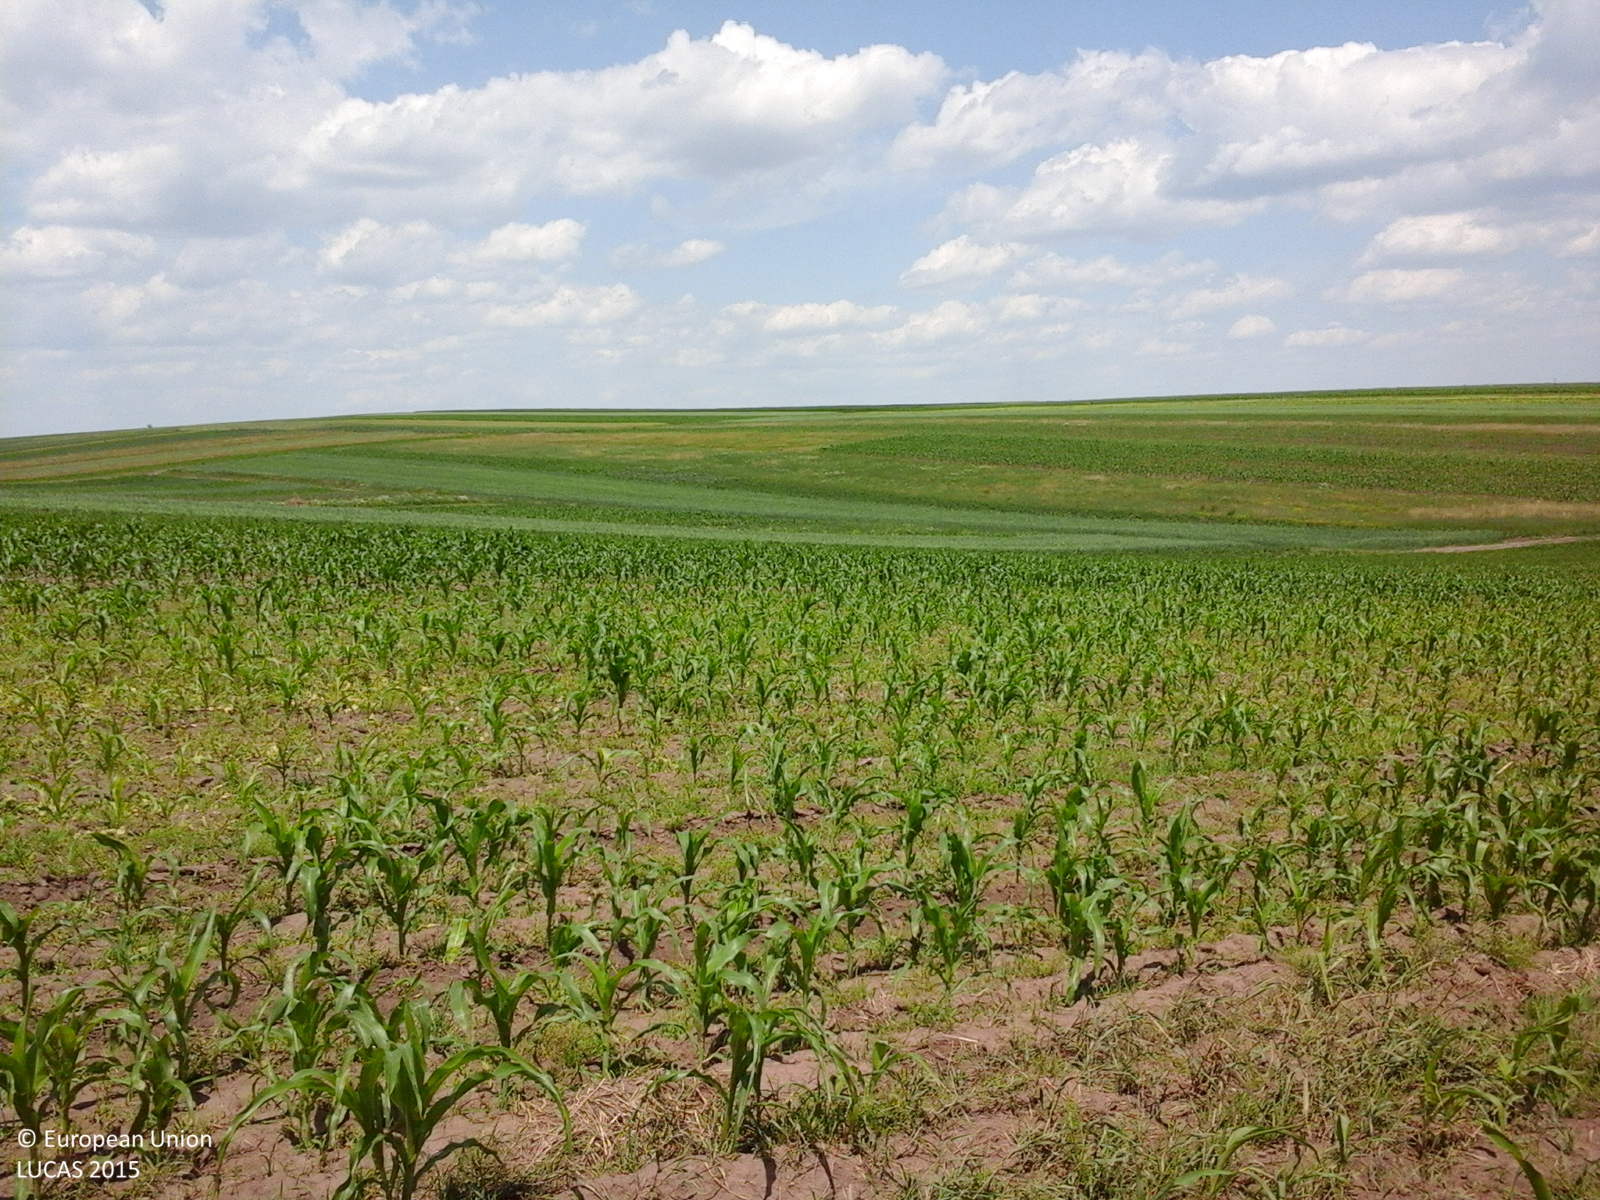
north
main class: Cropland
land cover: Maize
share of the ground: 25 - 50 %
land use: Agriculture (excluding fallow land and kitchen gardens)
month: June
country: RO
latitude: 47.5314
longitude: 26.3024
